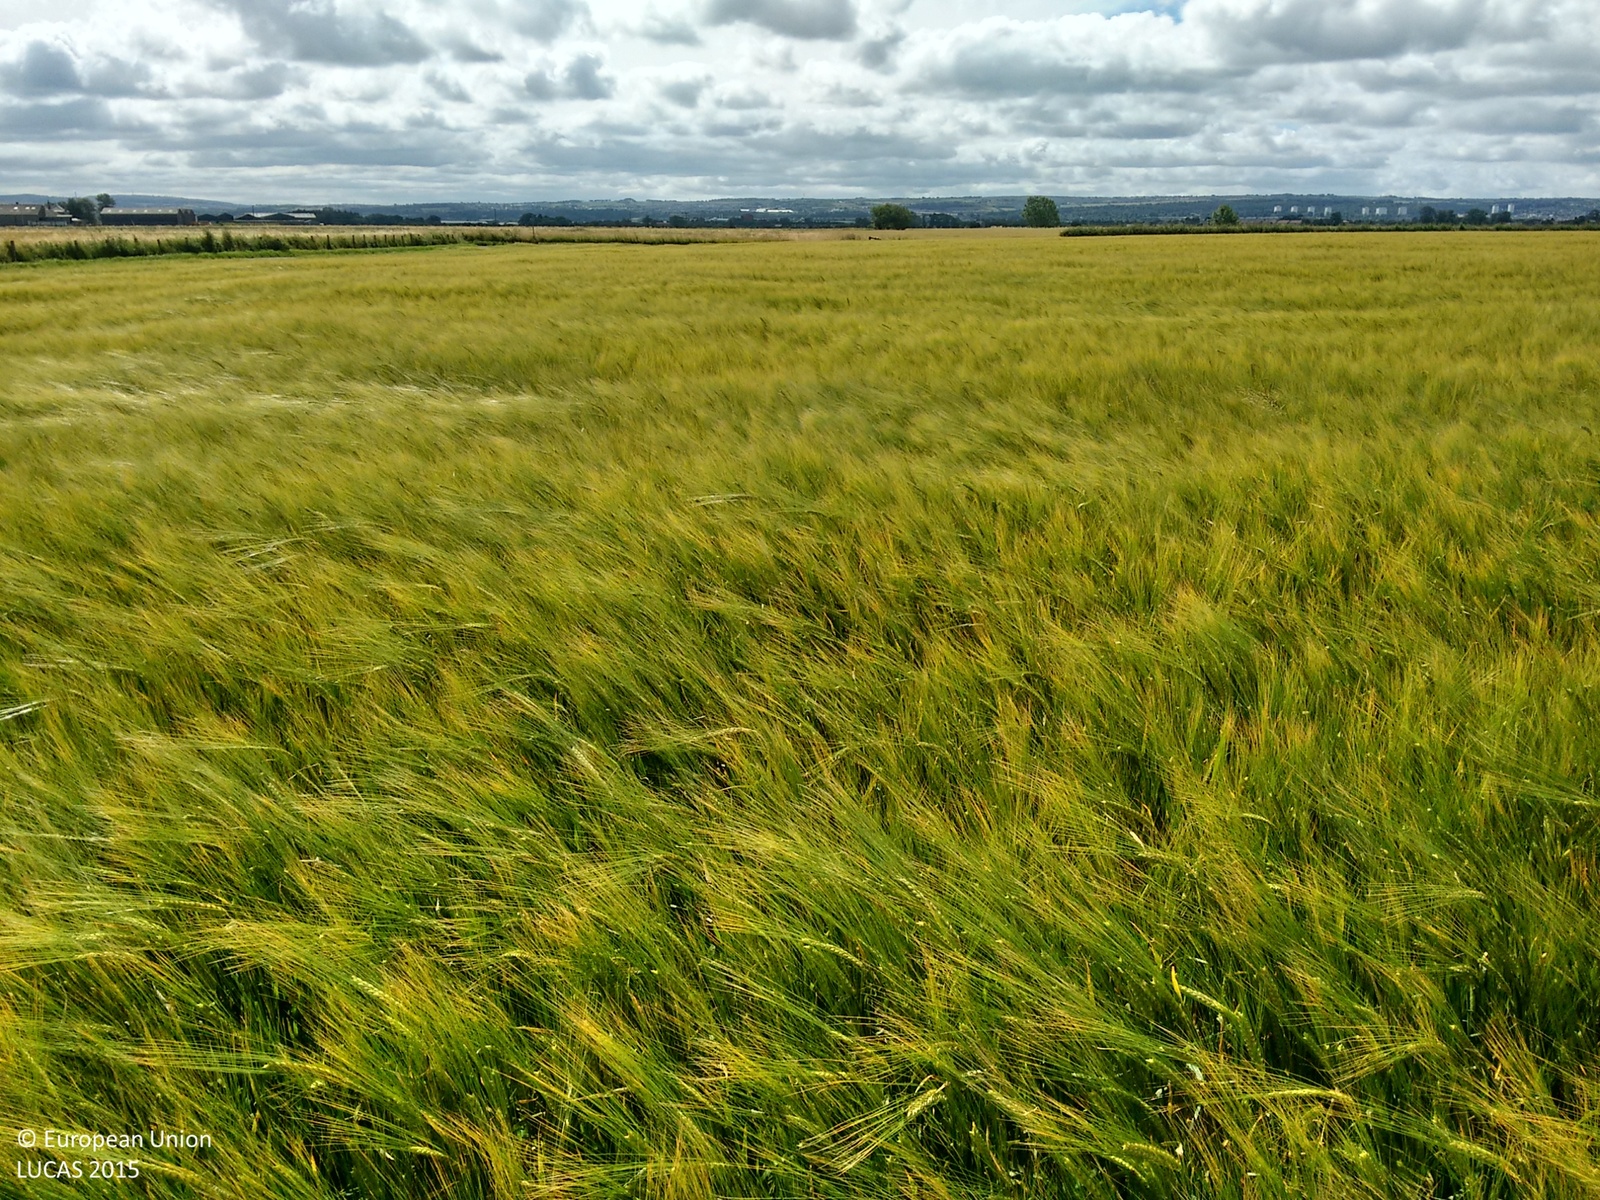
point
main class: Cropland
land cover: Barley
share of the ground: > 75 %
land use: Agriculture (excluding fallow land and kitchen gardens)
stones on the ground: < 10 %
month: August
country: GB
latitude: 56.0463
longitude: -3.7437
